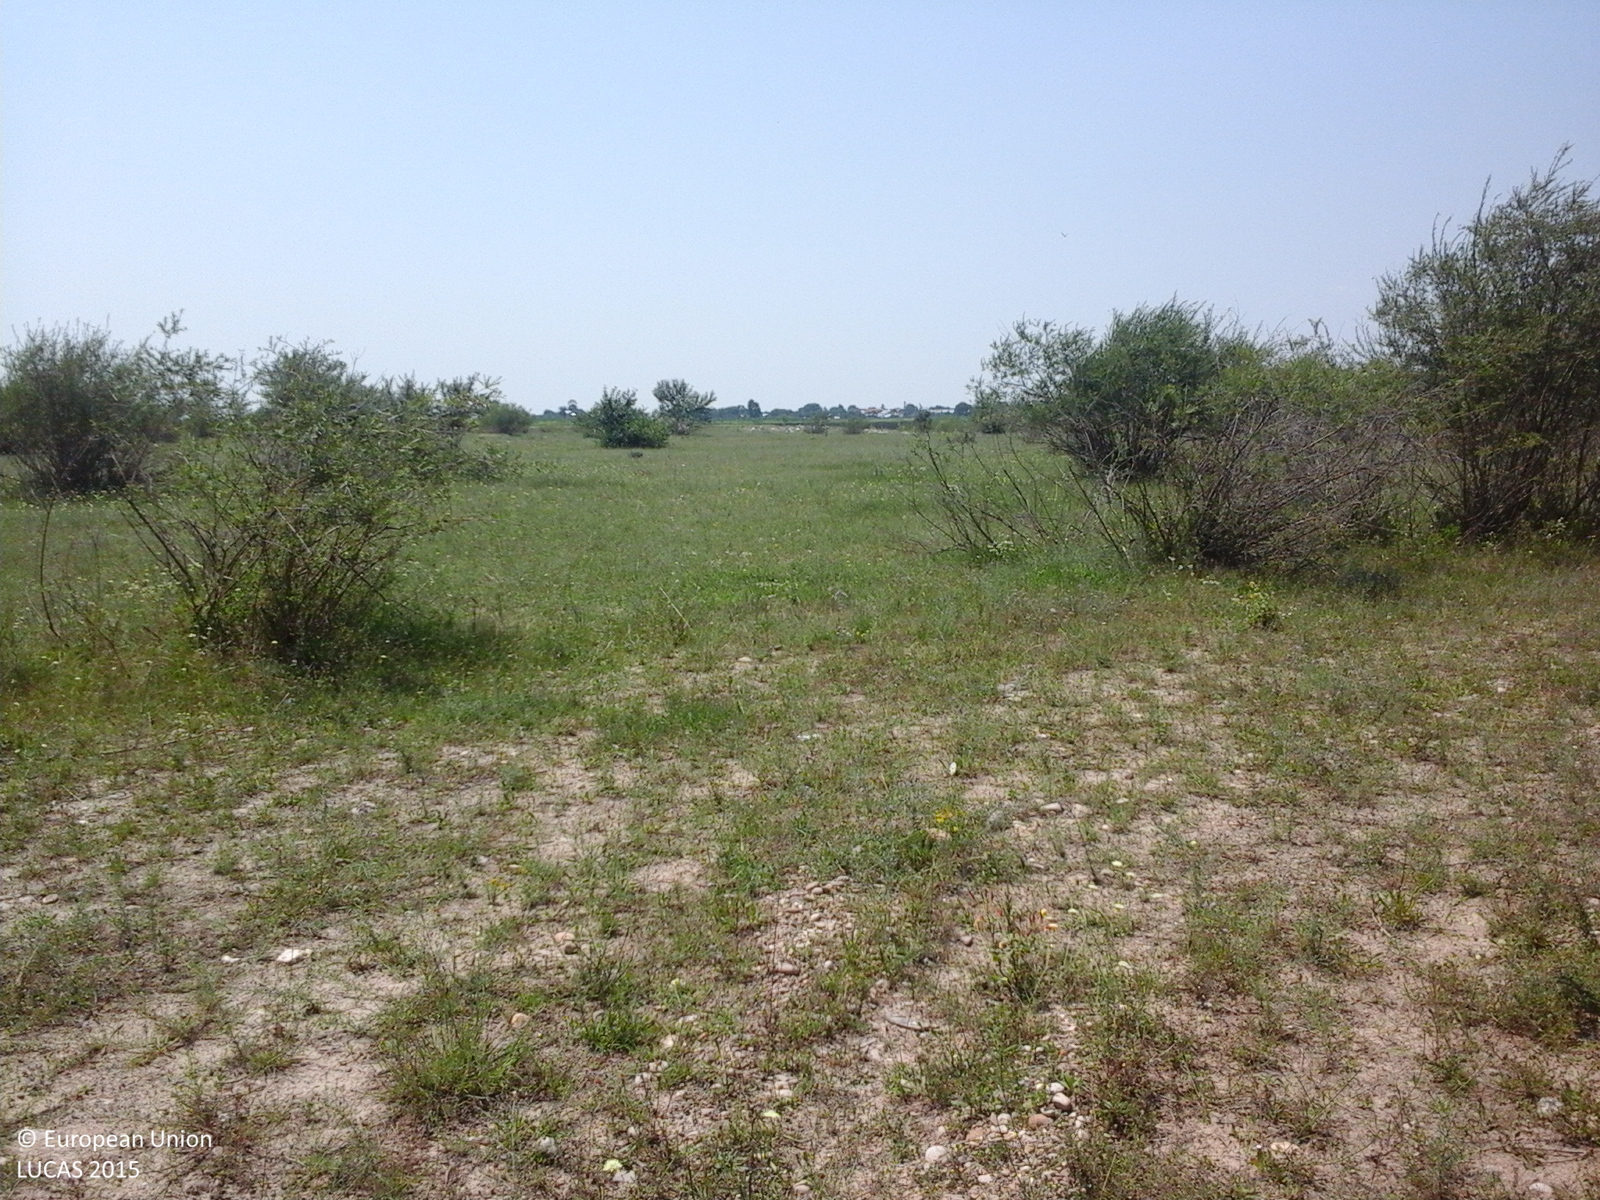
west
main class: Grassland
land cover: Spontaneously vegetated surfaces
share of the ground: 10 - 25 %
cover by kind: herbaceous plants 100 %
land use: Agriculture (excluding fallow land and kitchen gardens)
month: July
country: RO
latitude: 44.7921
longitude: 25.7359
